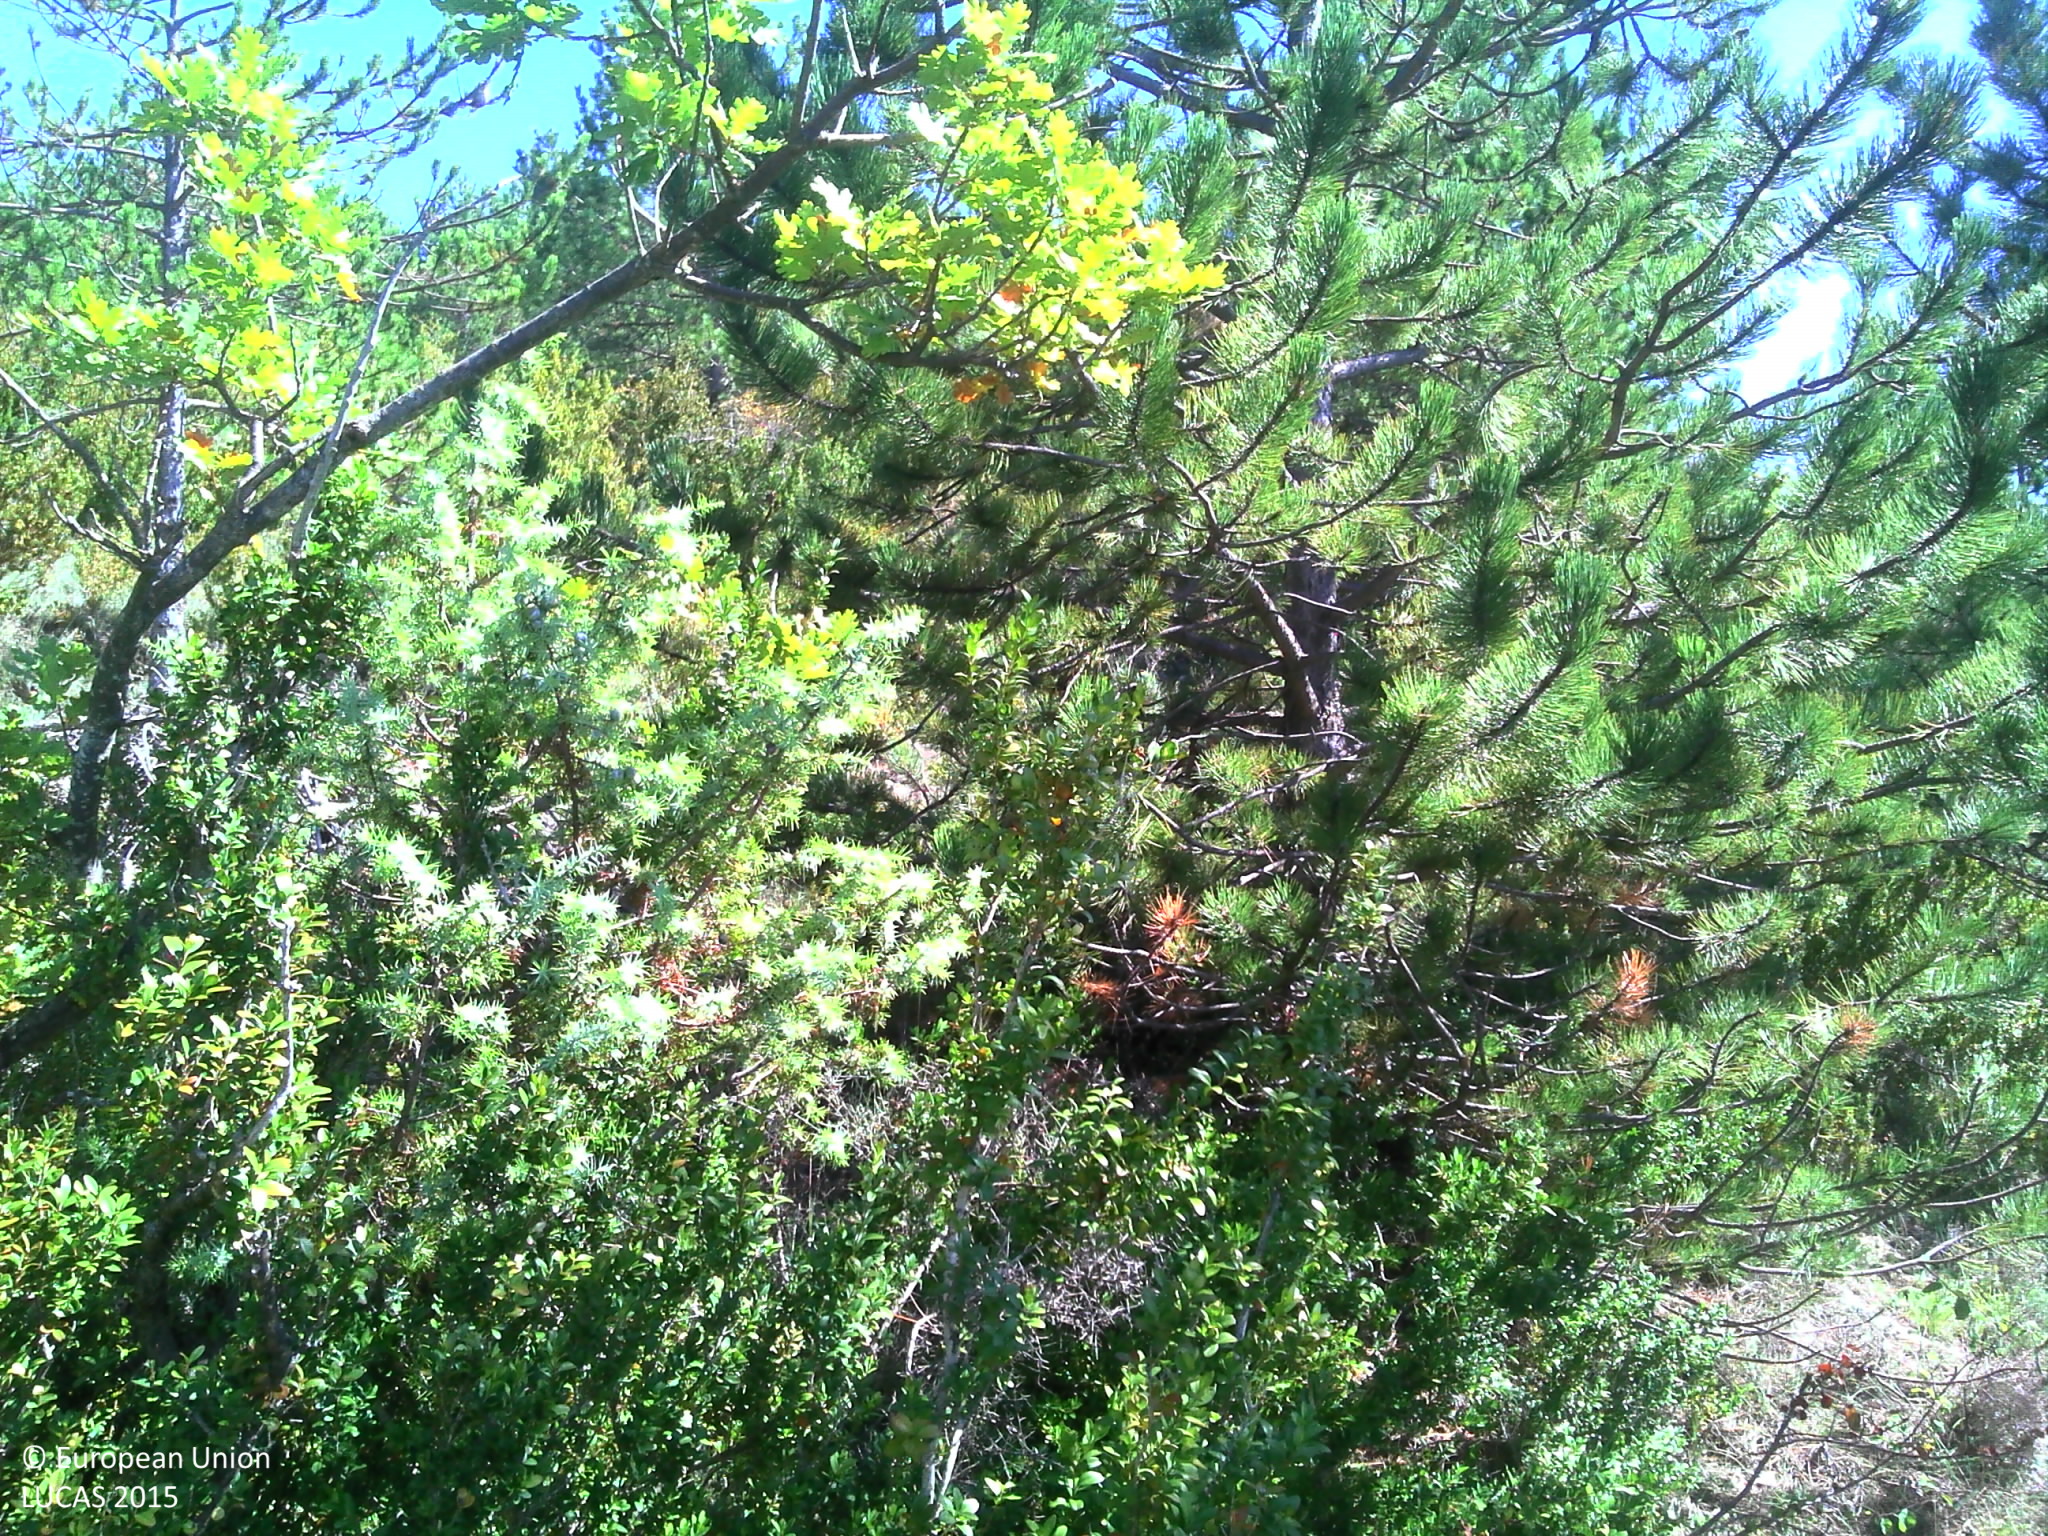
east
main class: Woodland
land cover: Pine dominated coniferous woodland
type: coniferous forest of the mediterranean region
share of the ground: > 75 %
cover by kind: coniferous forest trees 95 %, broadleaved forest trees 5 %
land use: Forestry
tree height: > 5 m
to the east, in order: Pine dominated coniferous woodland; Paved roads, cycling and walking lanes; Pine dominated coniferous woodland; Shrubland with sparse tree cover; Pine dominated coniferous woodland; Rivers and streams; Pine dominated coniferous woodland; Shrubland with sparse tree cover
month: September
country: FR
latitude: 44.3875
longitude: 5.2749
